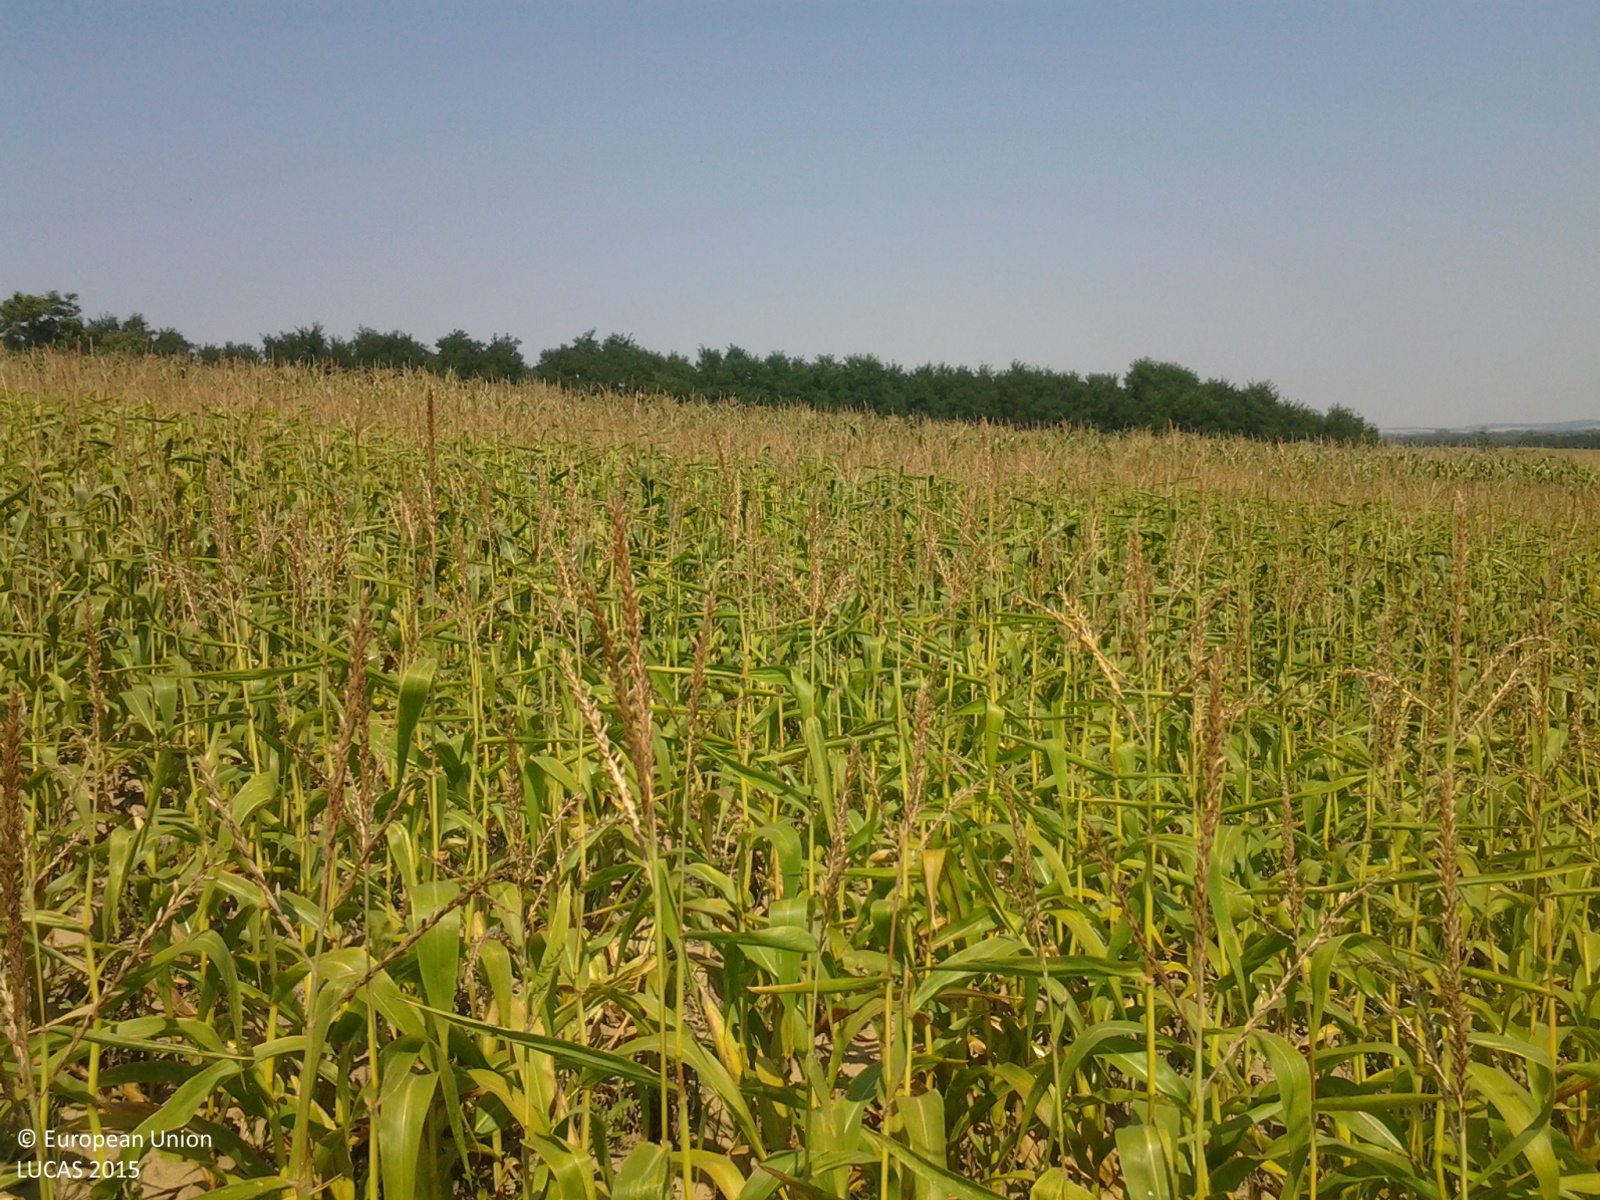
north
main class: Cropland
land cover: Maize
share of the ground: > 75 %
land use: Agriculture (excluding fallow land and kitchen gardens)
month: August
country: HU
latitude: 46.5764
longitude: 16.9578
